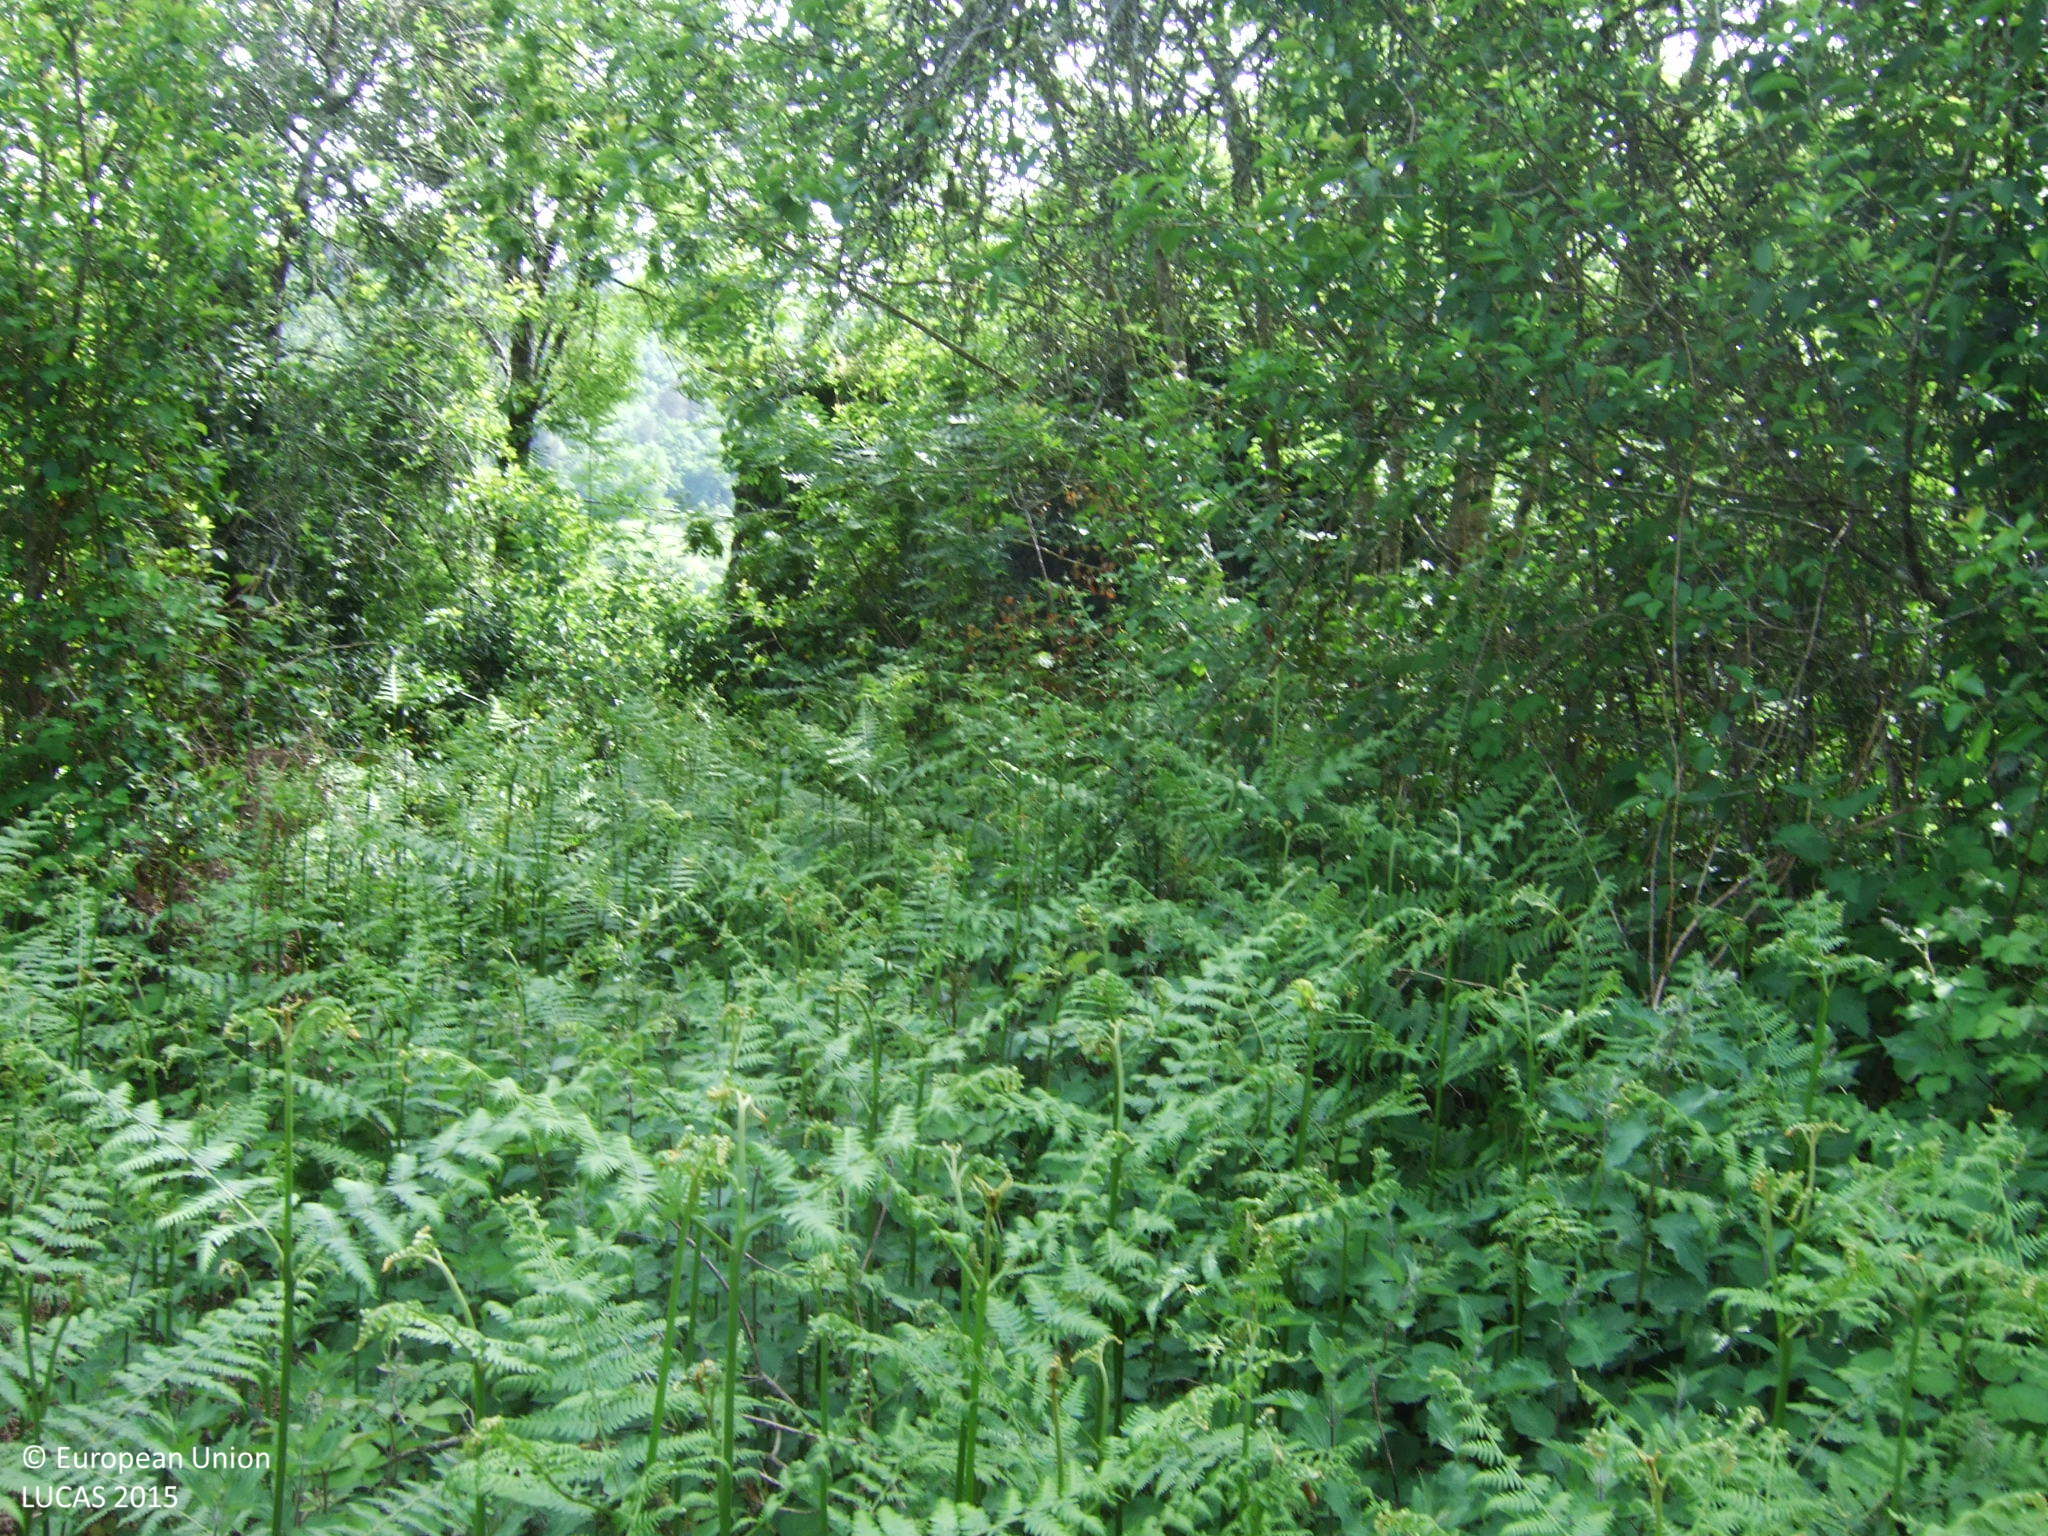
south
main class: Grassland
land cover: Grassland without tree/shrub cover
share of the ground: > 75 %
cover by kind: herbaceous plants 100 %
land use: Agriculture (excluding fallow land and kitchen gardens)
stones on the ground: < 10 %
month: May
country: ES
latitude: 42.8672
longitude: -7.2904
